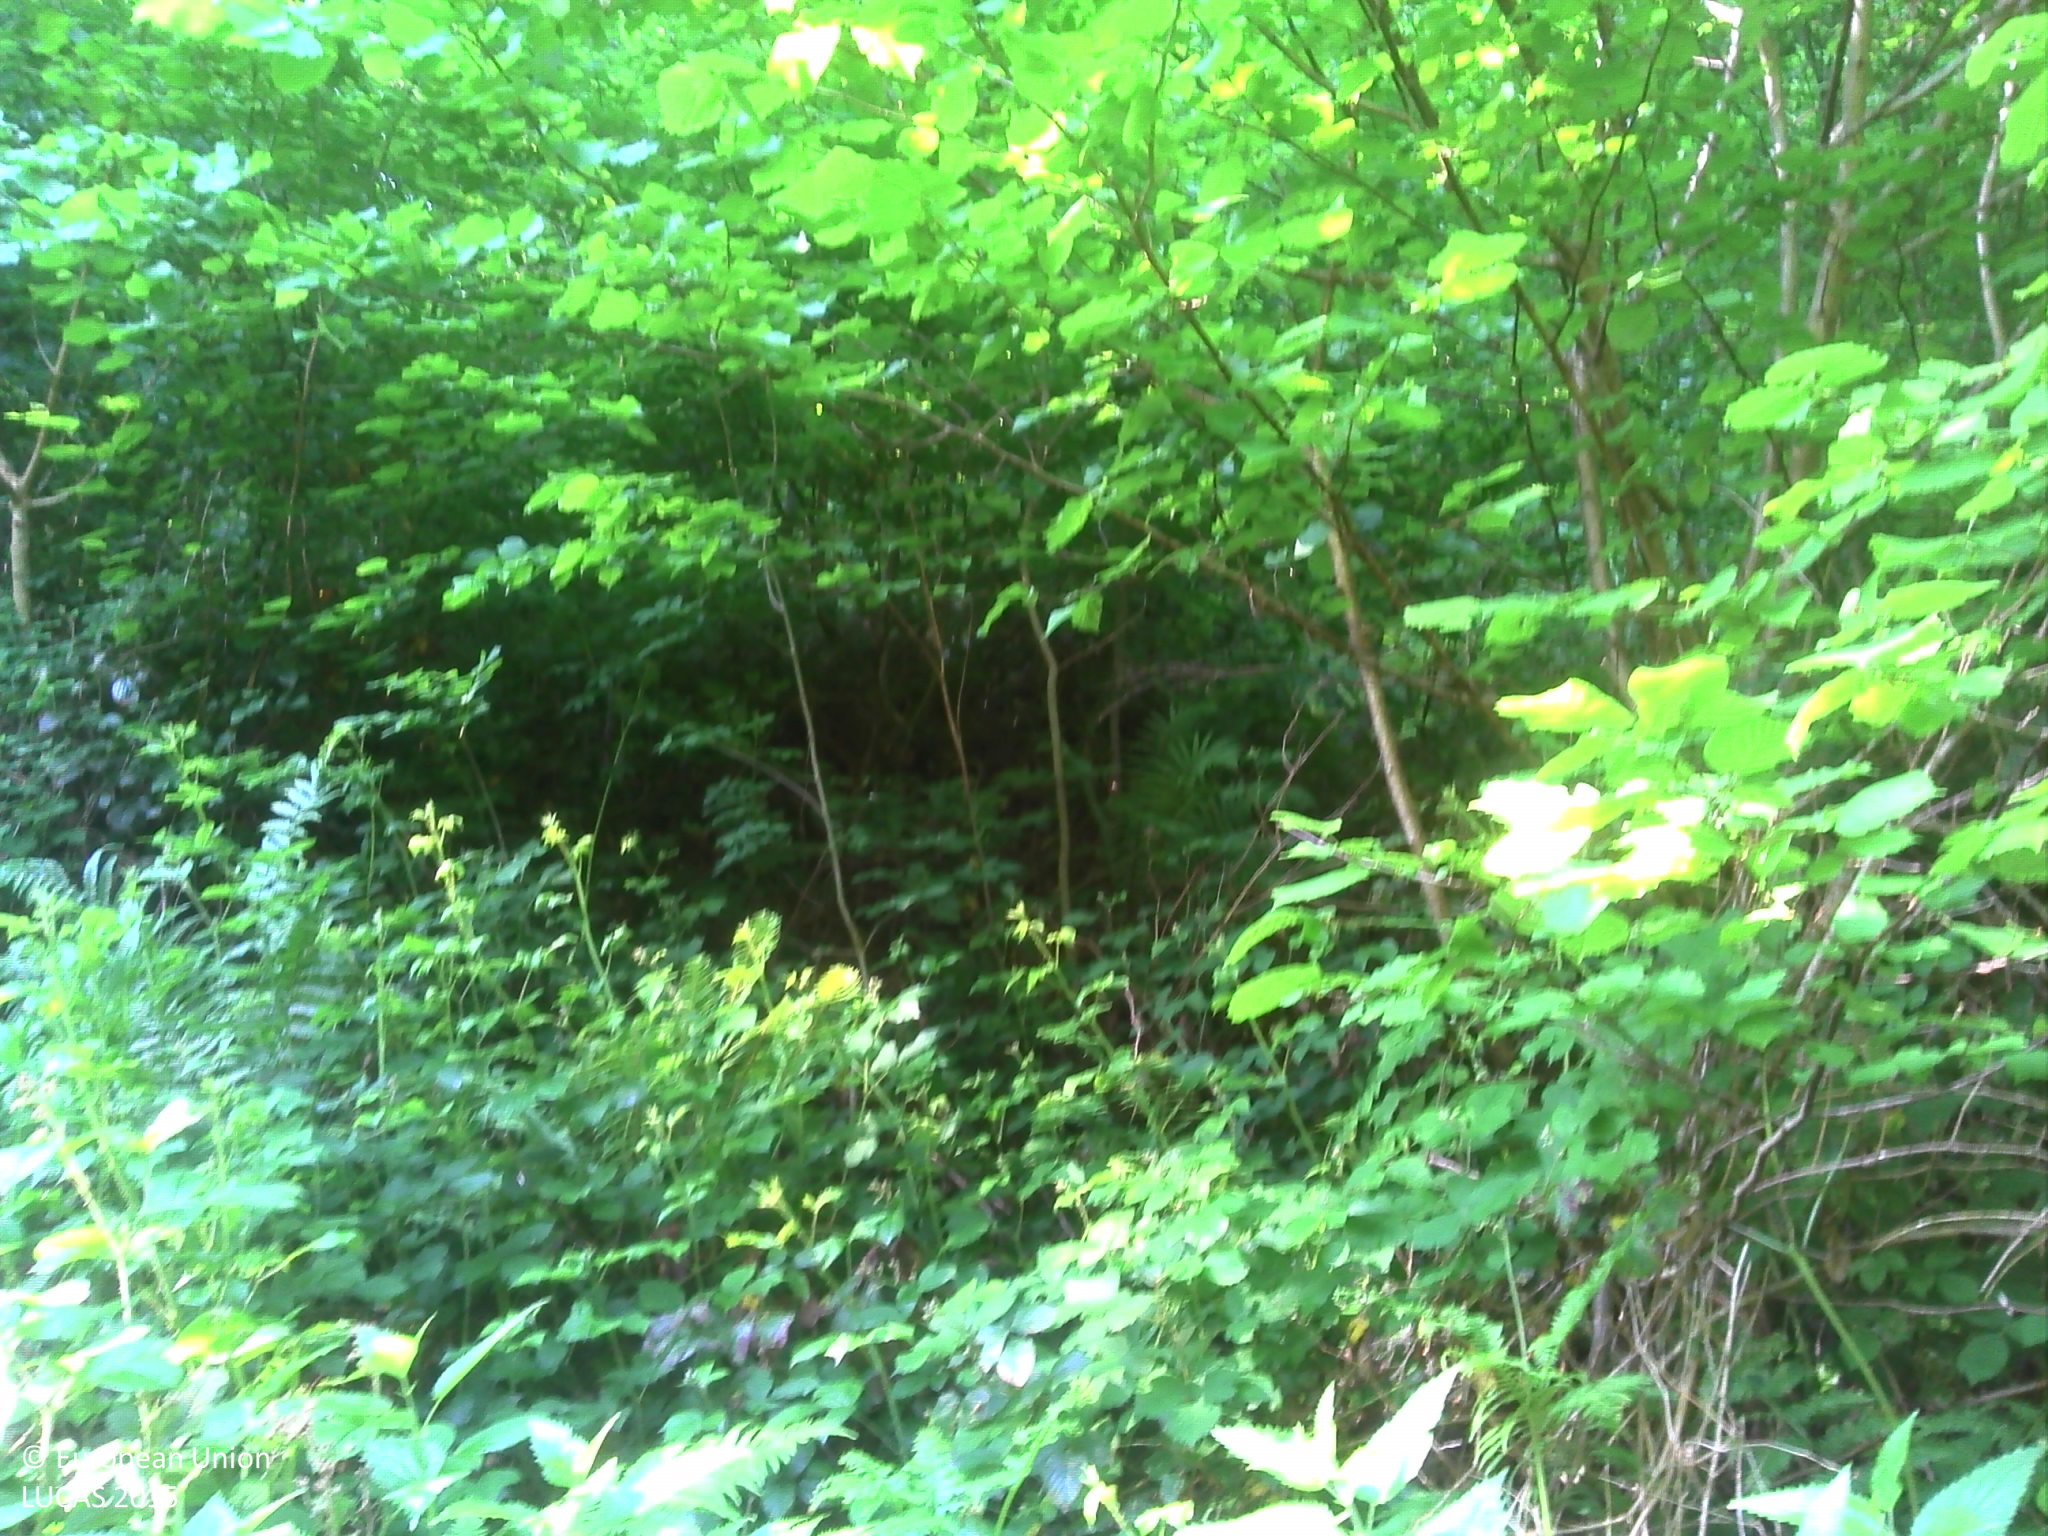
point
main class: Woodland
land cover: Broadleaved woodland
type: mesophytic deciduous forest
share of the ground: > 75 %
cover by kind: broadleaved forest trees 100 %
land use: Forestry
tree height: > 5 m
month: June
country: FR
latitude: 43.4141
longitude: 2.0899
